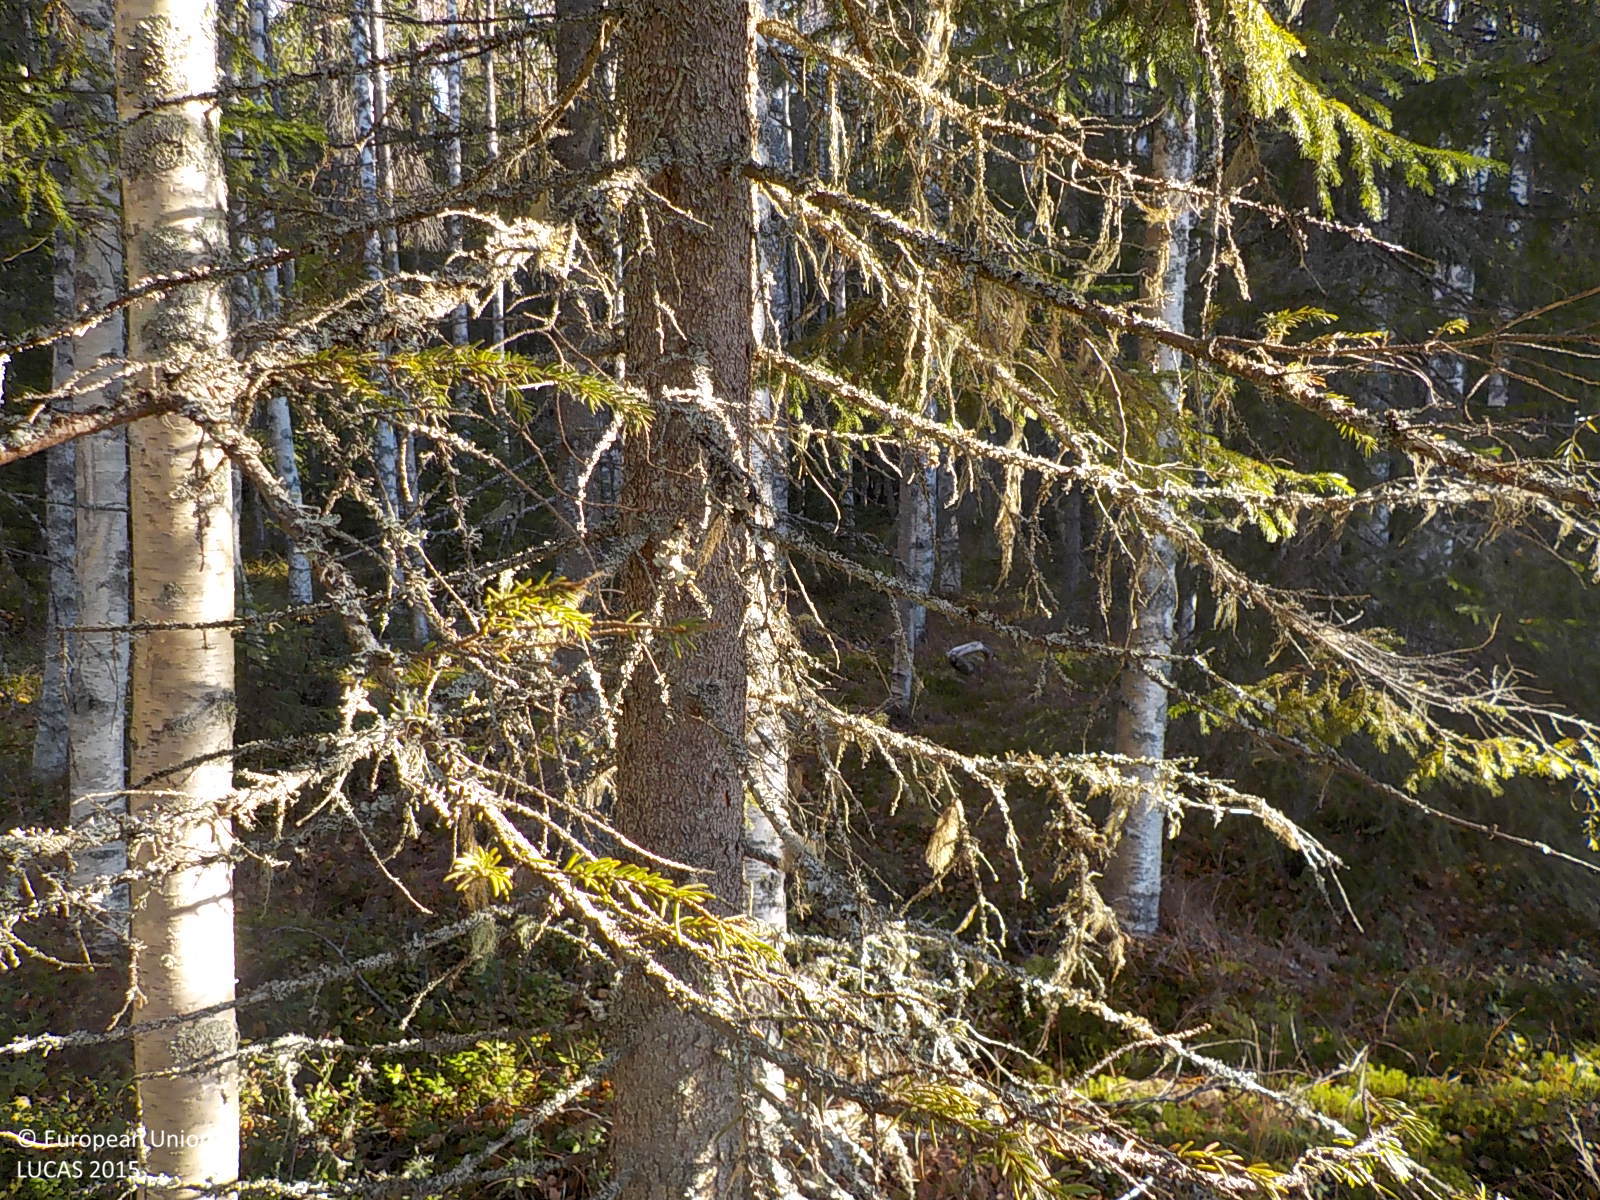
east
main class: Woodland
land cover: Spruce dominated mixed woodland
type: boreal forest
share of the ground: > 75 %
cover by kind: coniferous forest trees 50 %, broadleaved forest trees 45 %, shrubs 5 %
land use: Forestry
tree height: > 5 m
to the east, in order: Spruce dominated mixed woodland; Pine dominated mixed woodland; Broadleaved woodland; Other mixed woodland; Inland marshes; Inland fresh water bodies
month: October
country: SE
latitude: 63.2858
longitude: 18.0515
